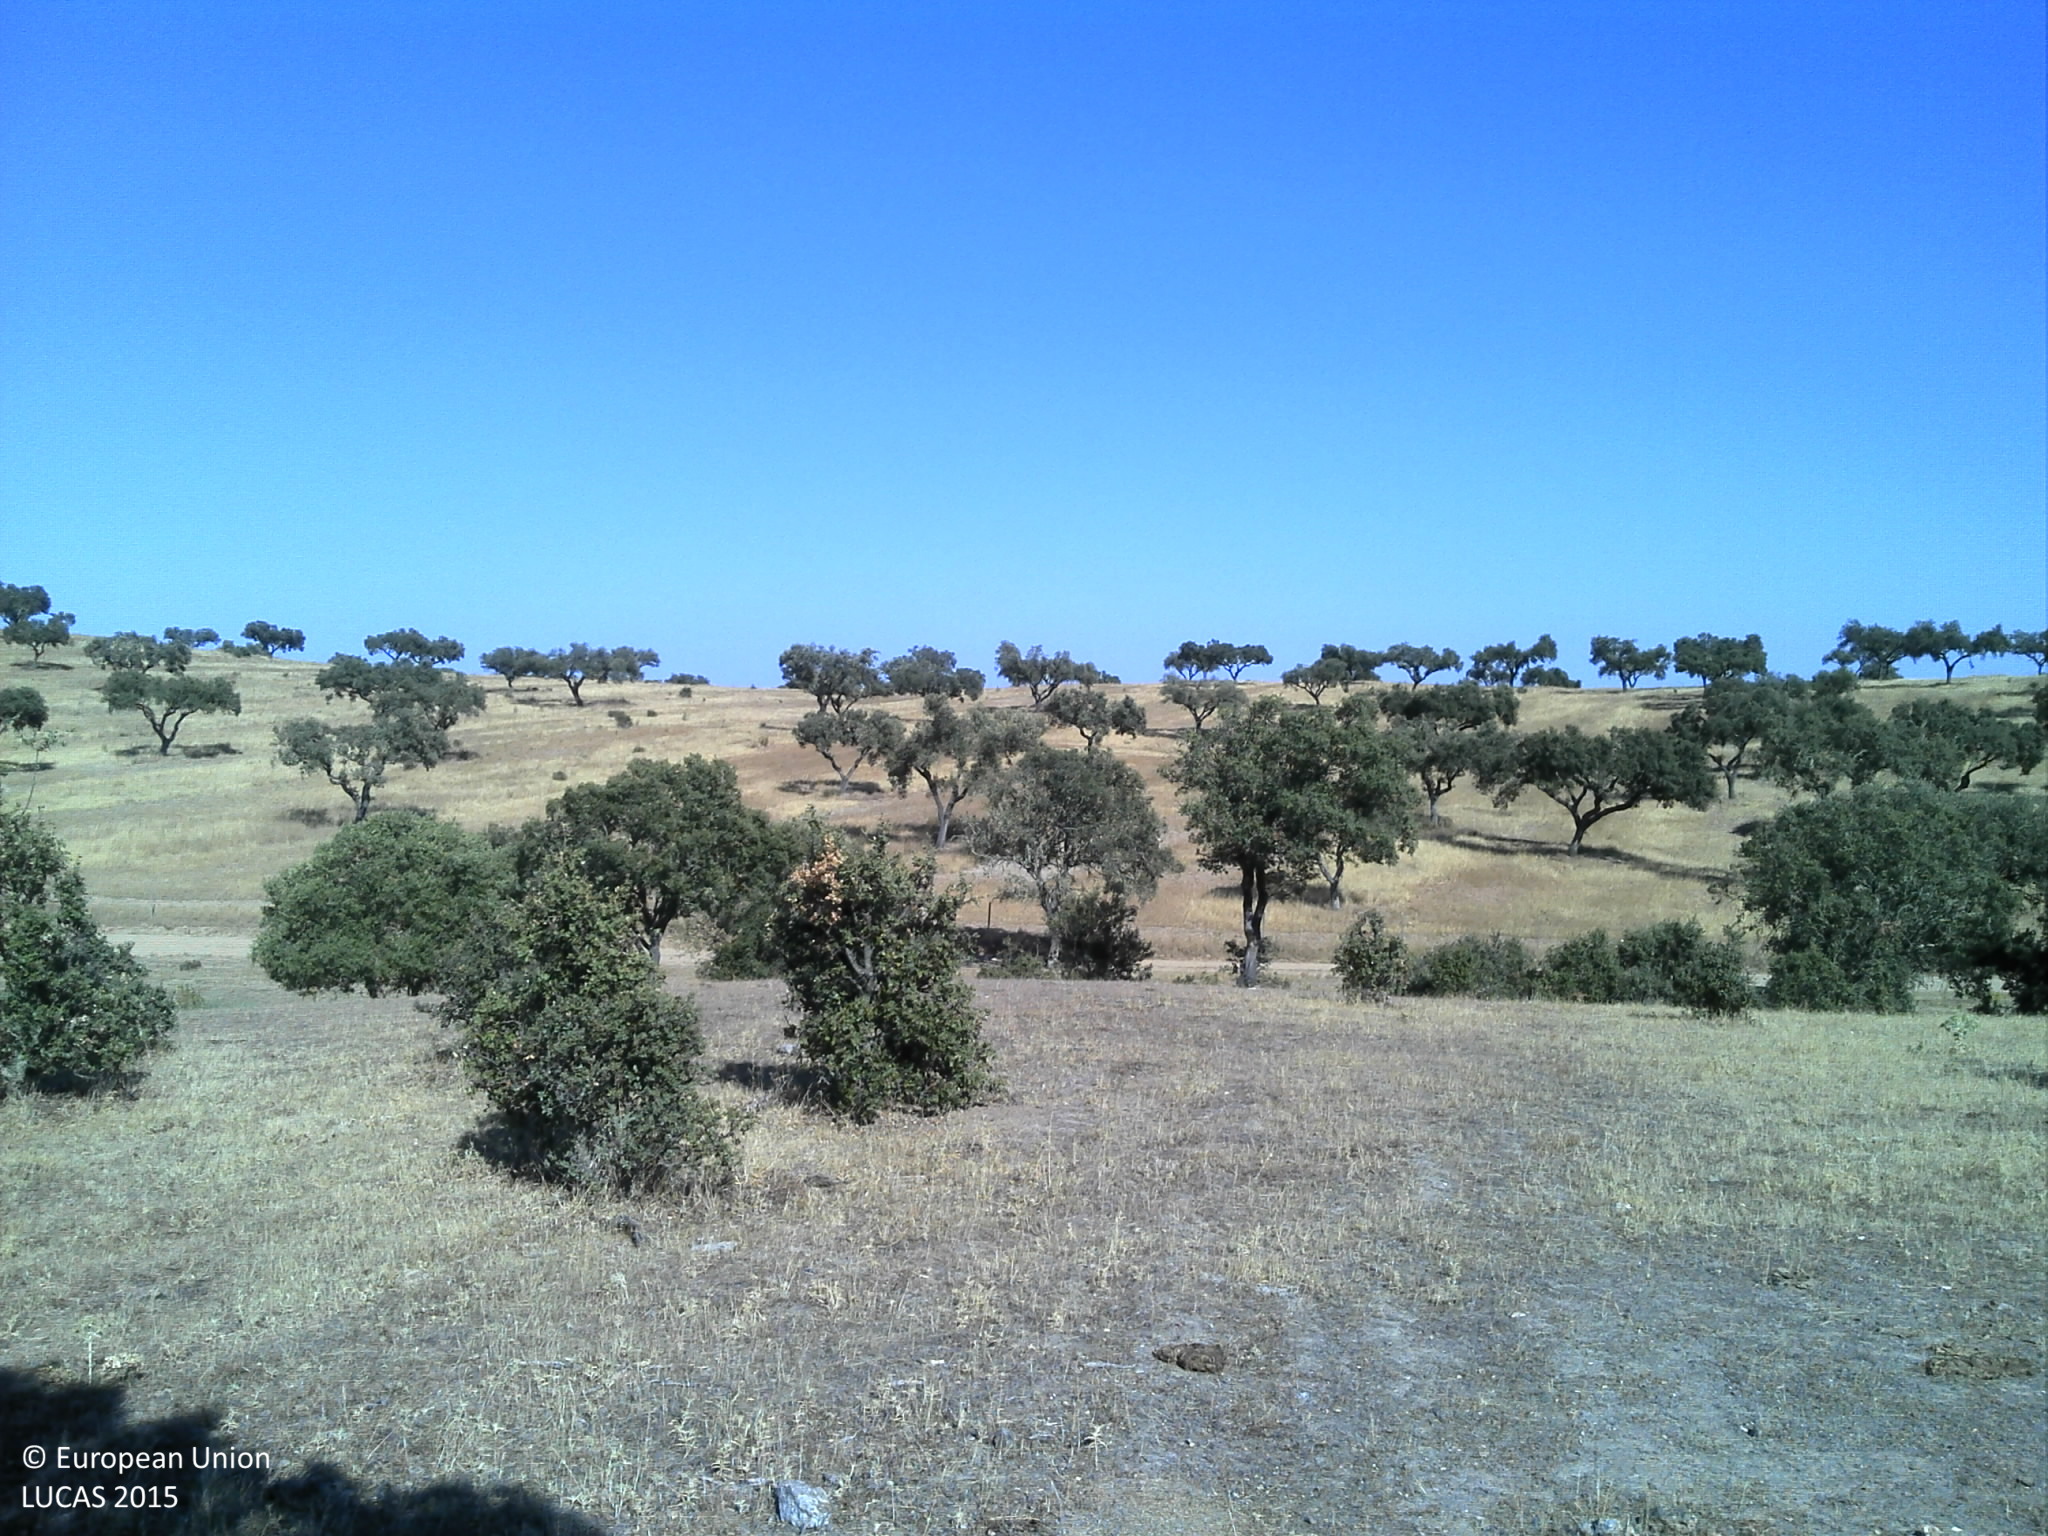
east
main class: Grassland
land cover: Grassland with sparse tree/shrub cover
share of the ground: 10 - 25 %
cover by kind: unconsolidated bare surface 70 %, herbaceous plants 25 %, broadleaved forest trees 5 %
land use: Agriculture (excluding fallow land and kitchen gardens)
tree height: < 5 m
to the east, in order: Grassland with sparse tree/shrub cover; Grassland without tree/shrub cover; Rivers and streams; Grassland without tree/shrub cover; Tracks; Grass margins; Fences; Other bare soil; Grassland without tree/shrub cover; Broadleaved woodland; Grassland without tree/shrub cover; Broadleaved woodland
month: July
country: PT
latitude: 38.5058
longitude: -7.4463
